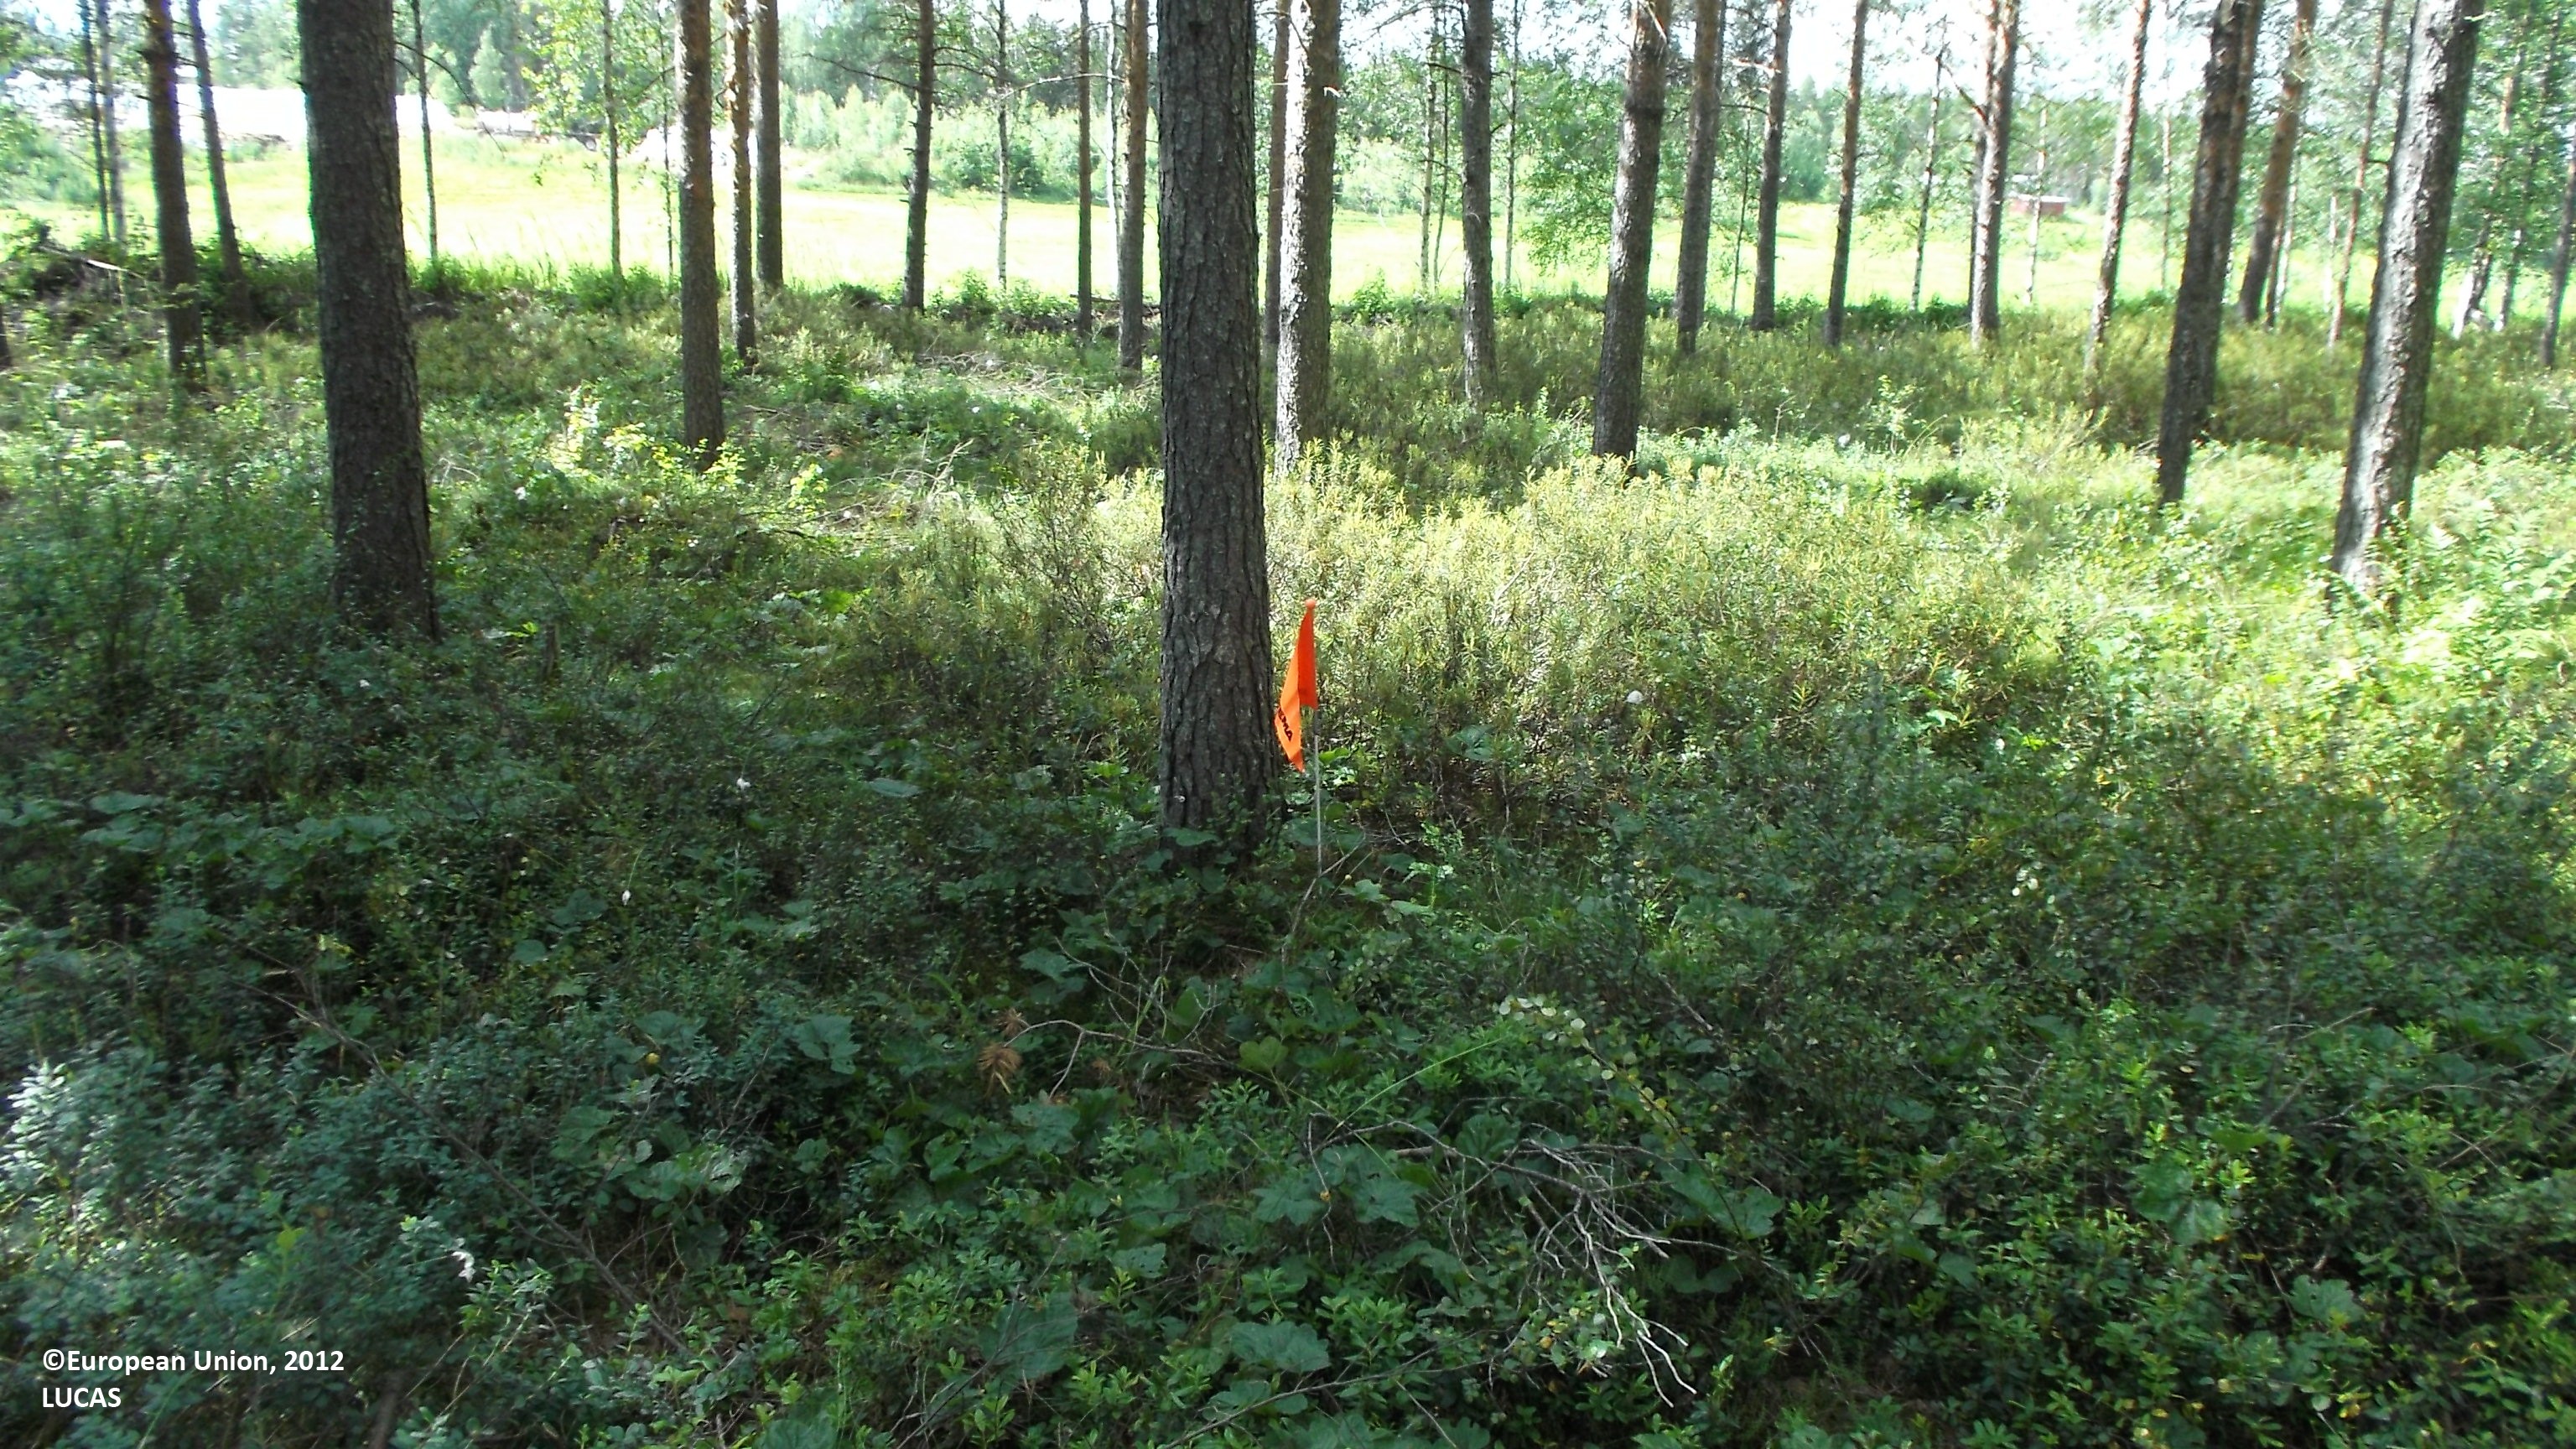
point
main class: Woodland
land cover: Pine dominated coniferous woodland
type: boreal forest
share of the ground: 25 - 50 %
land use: Forestry
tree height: > 5 m
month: July
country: FI
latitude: 63.3118
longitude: 23.8193
